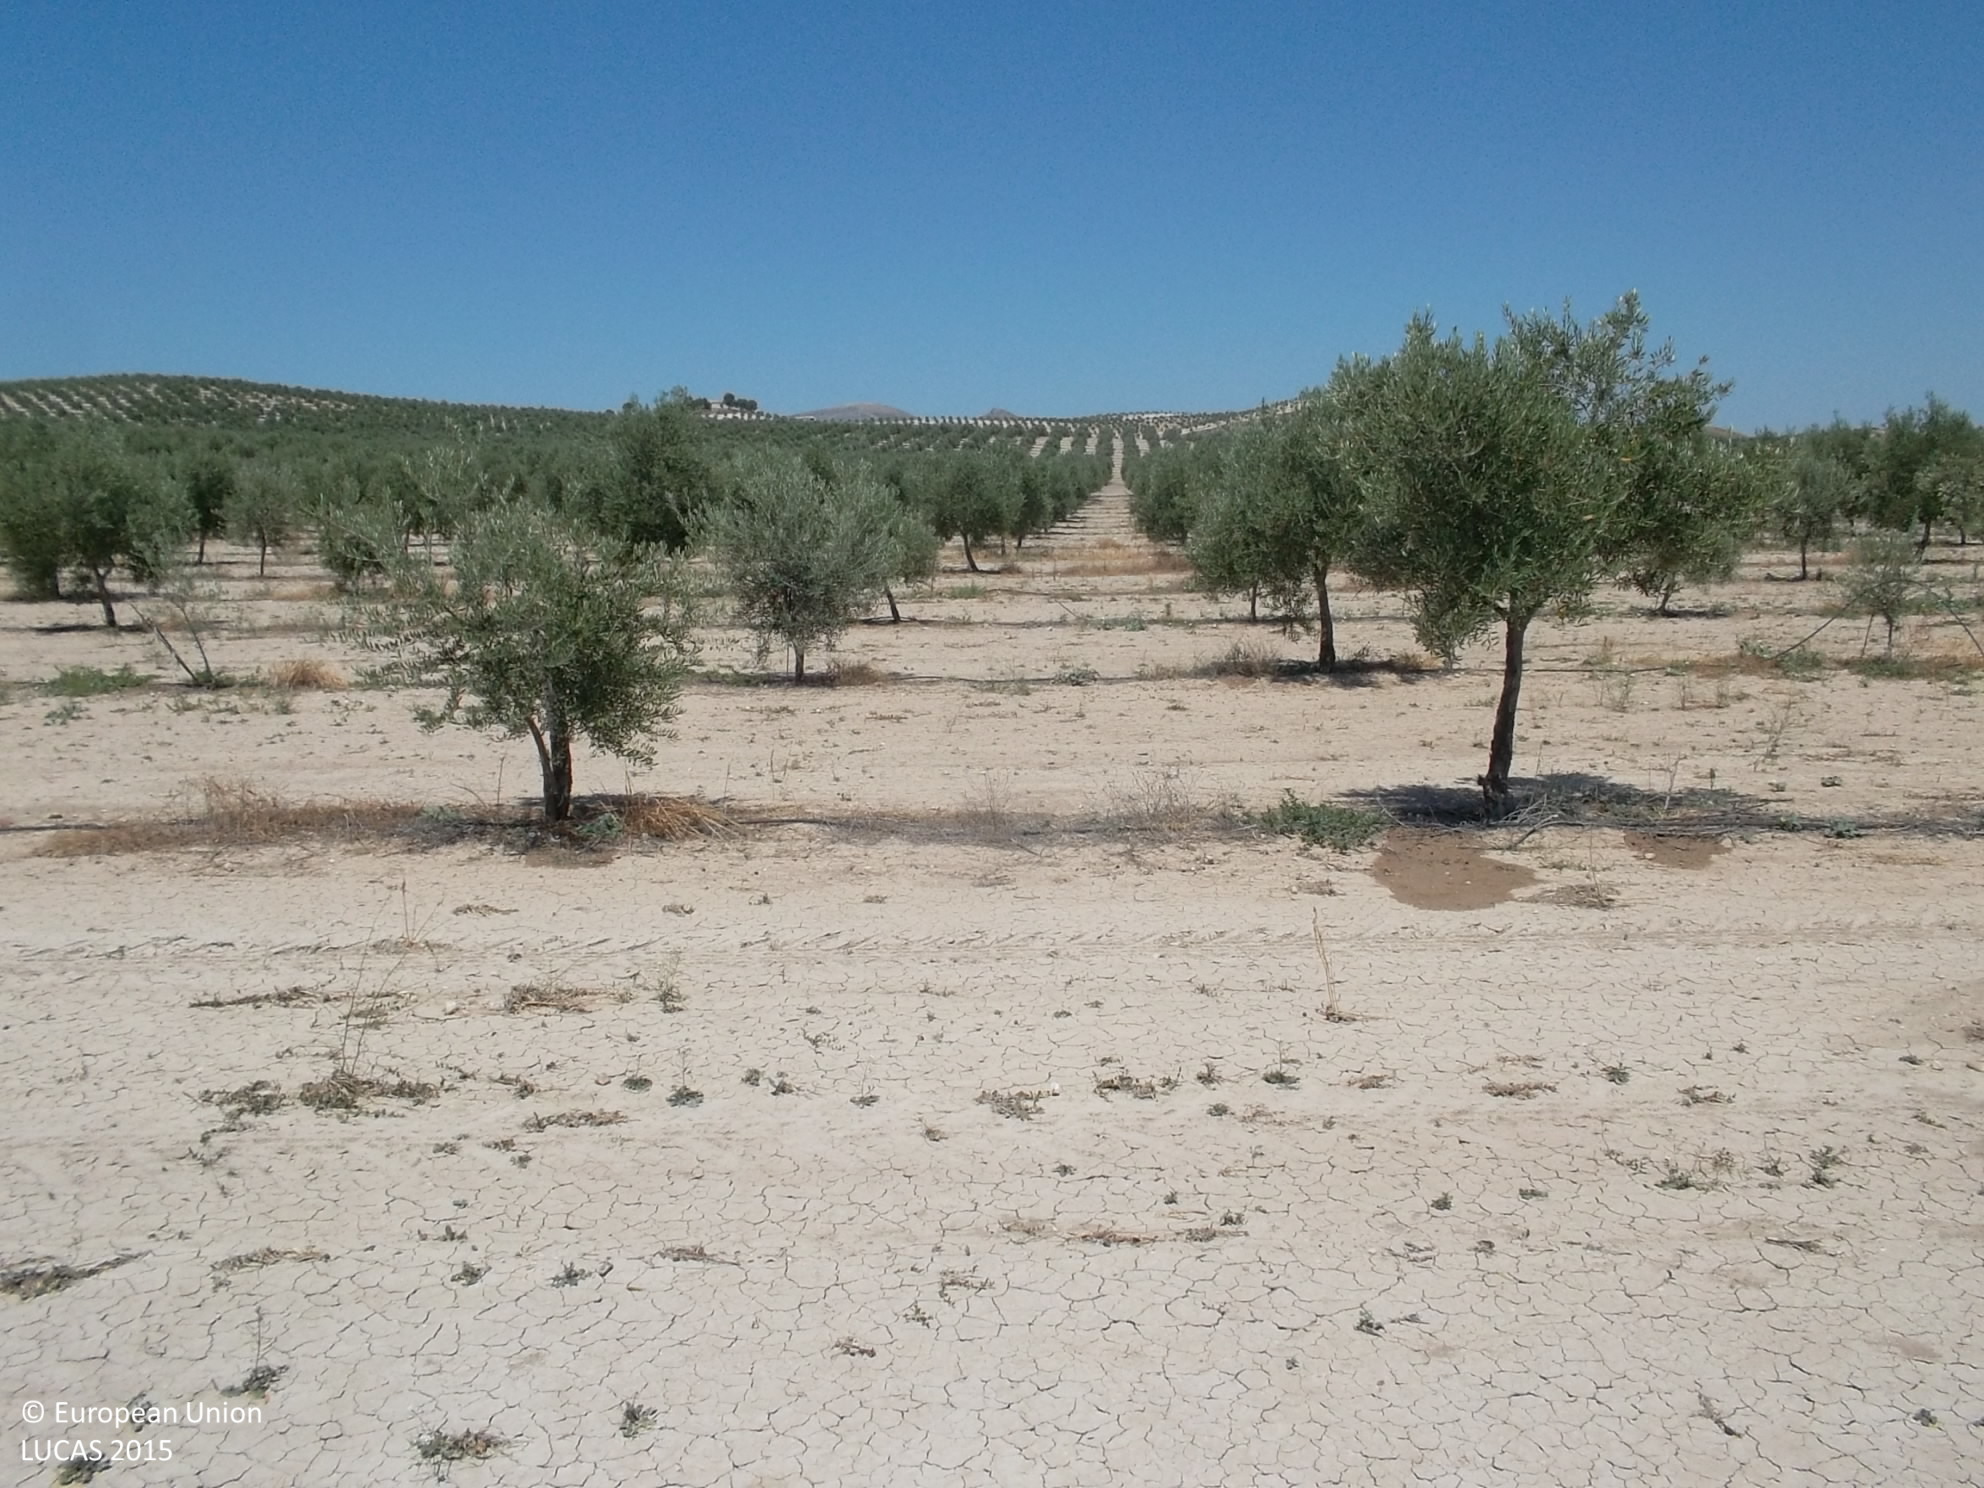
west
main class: Cropland
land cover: Olive groves
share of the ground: 25 - 50 %
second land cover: Other bare soil
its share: > 75 %
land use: Agriculture (excluding fallow land and kitchen gardens)
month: June
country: ES
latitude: 37.8454
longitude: -3.2354
